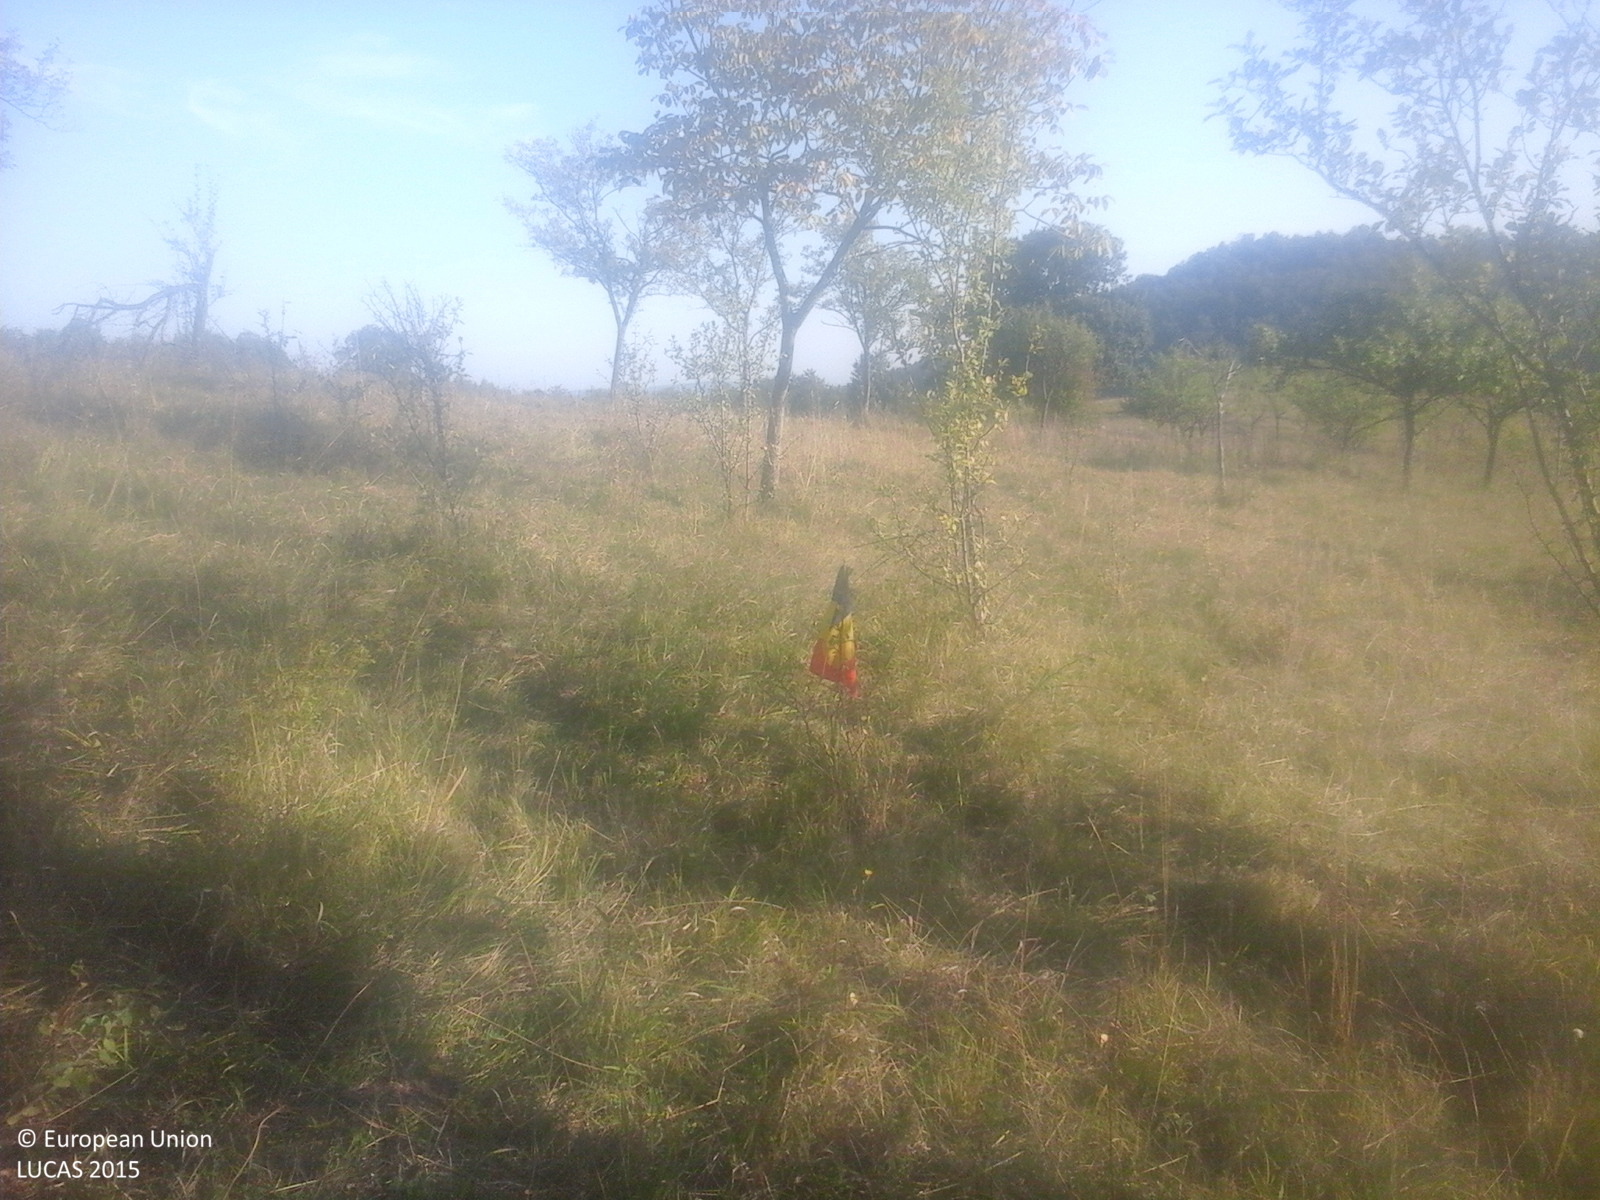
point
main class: Cropland
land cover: Apple fruit
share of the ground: > 75 %
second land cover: Grassland without tree/shrub cover
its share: > 75 %
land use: Agriculture (excluding fallow land and kitchen gardens)
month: September
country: RO
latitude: 46.6527
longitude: 22.1869
